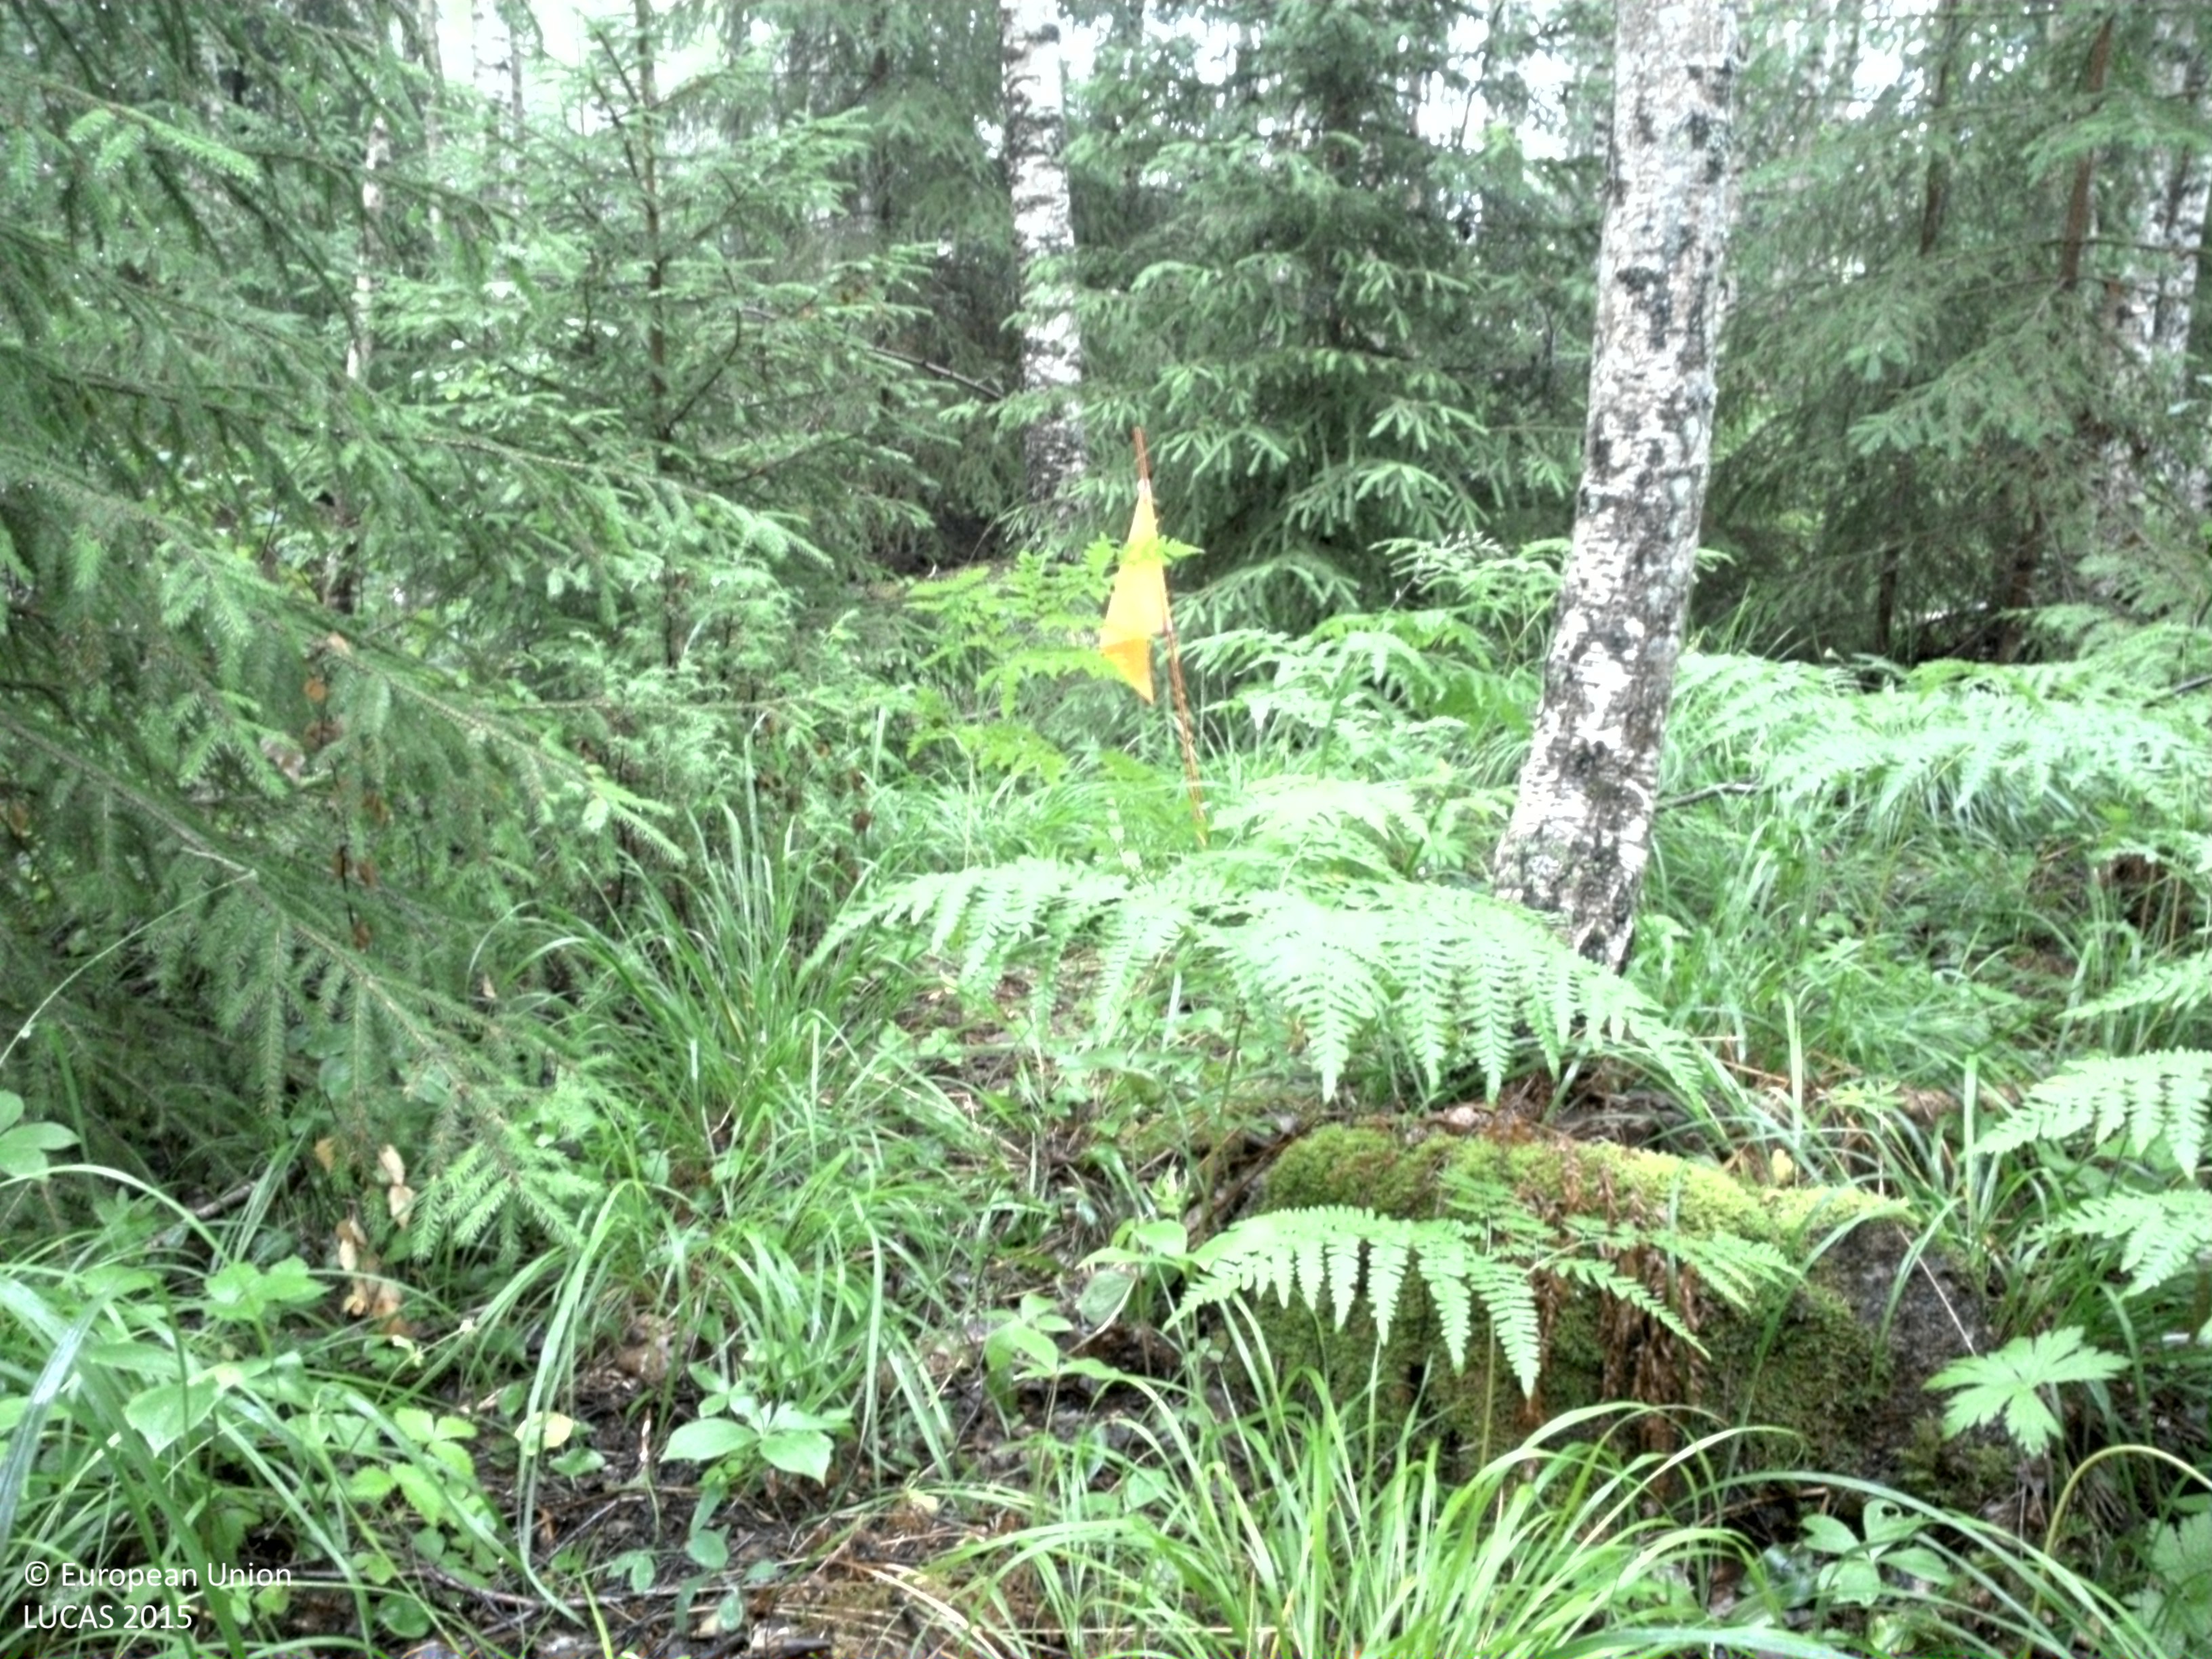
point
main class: Woodland
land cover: Other mixed woodland
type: boreal forest
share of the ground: > 75 %
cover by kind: broadleaved forest trees 50 %, coniferous forest trees 40 %, herbaceous plants 10 %
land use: Forestry
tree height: > 5 m
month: July
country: SE
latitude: 60.0871
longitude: 17.2008
